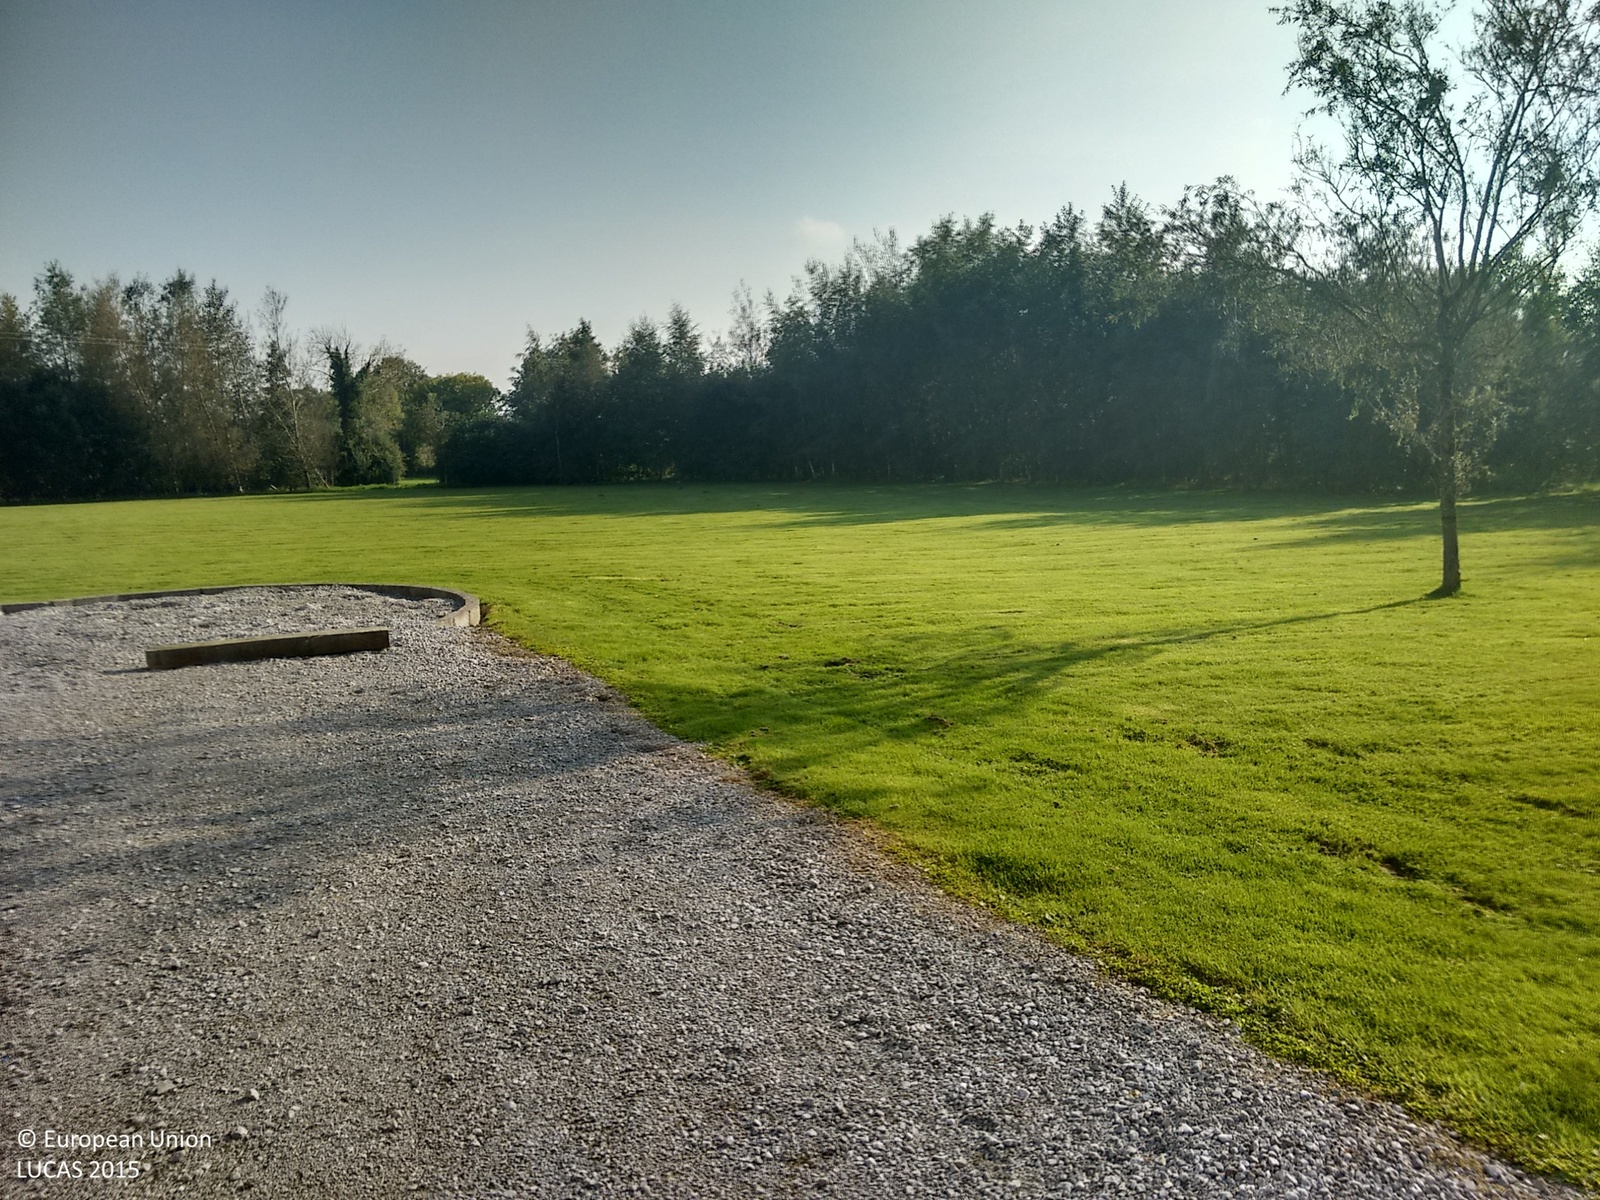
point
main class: Grassland
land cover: Grassland without tree/shrub cover
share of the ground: > 75 %
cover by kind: herbaceous plants 100 %
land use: Residential
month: October
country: IE
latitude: 52.4355
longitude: -9.0885
